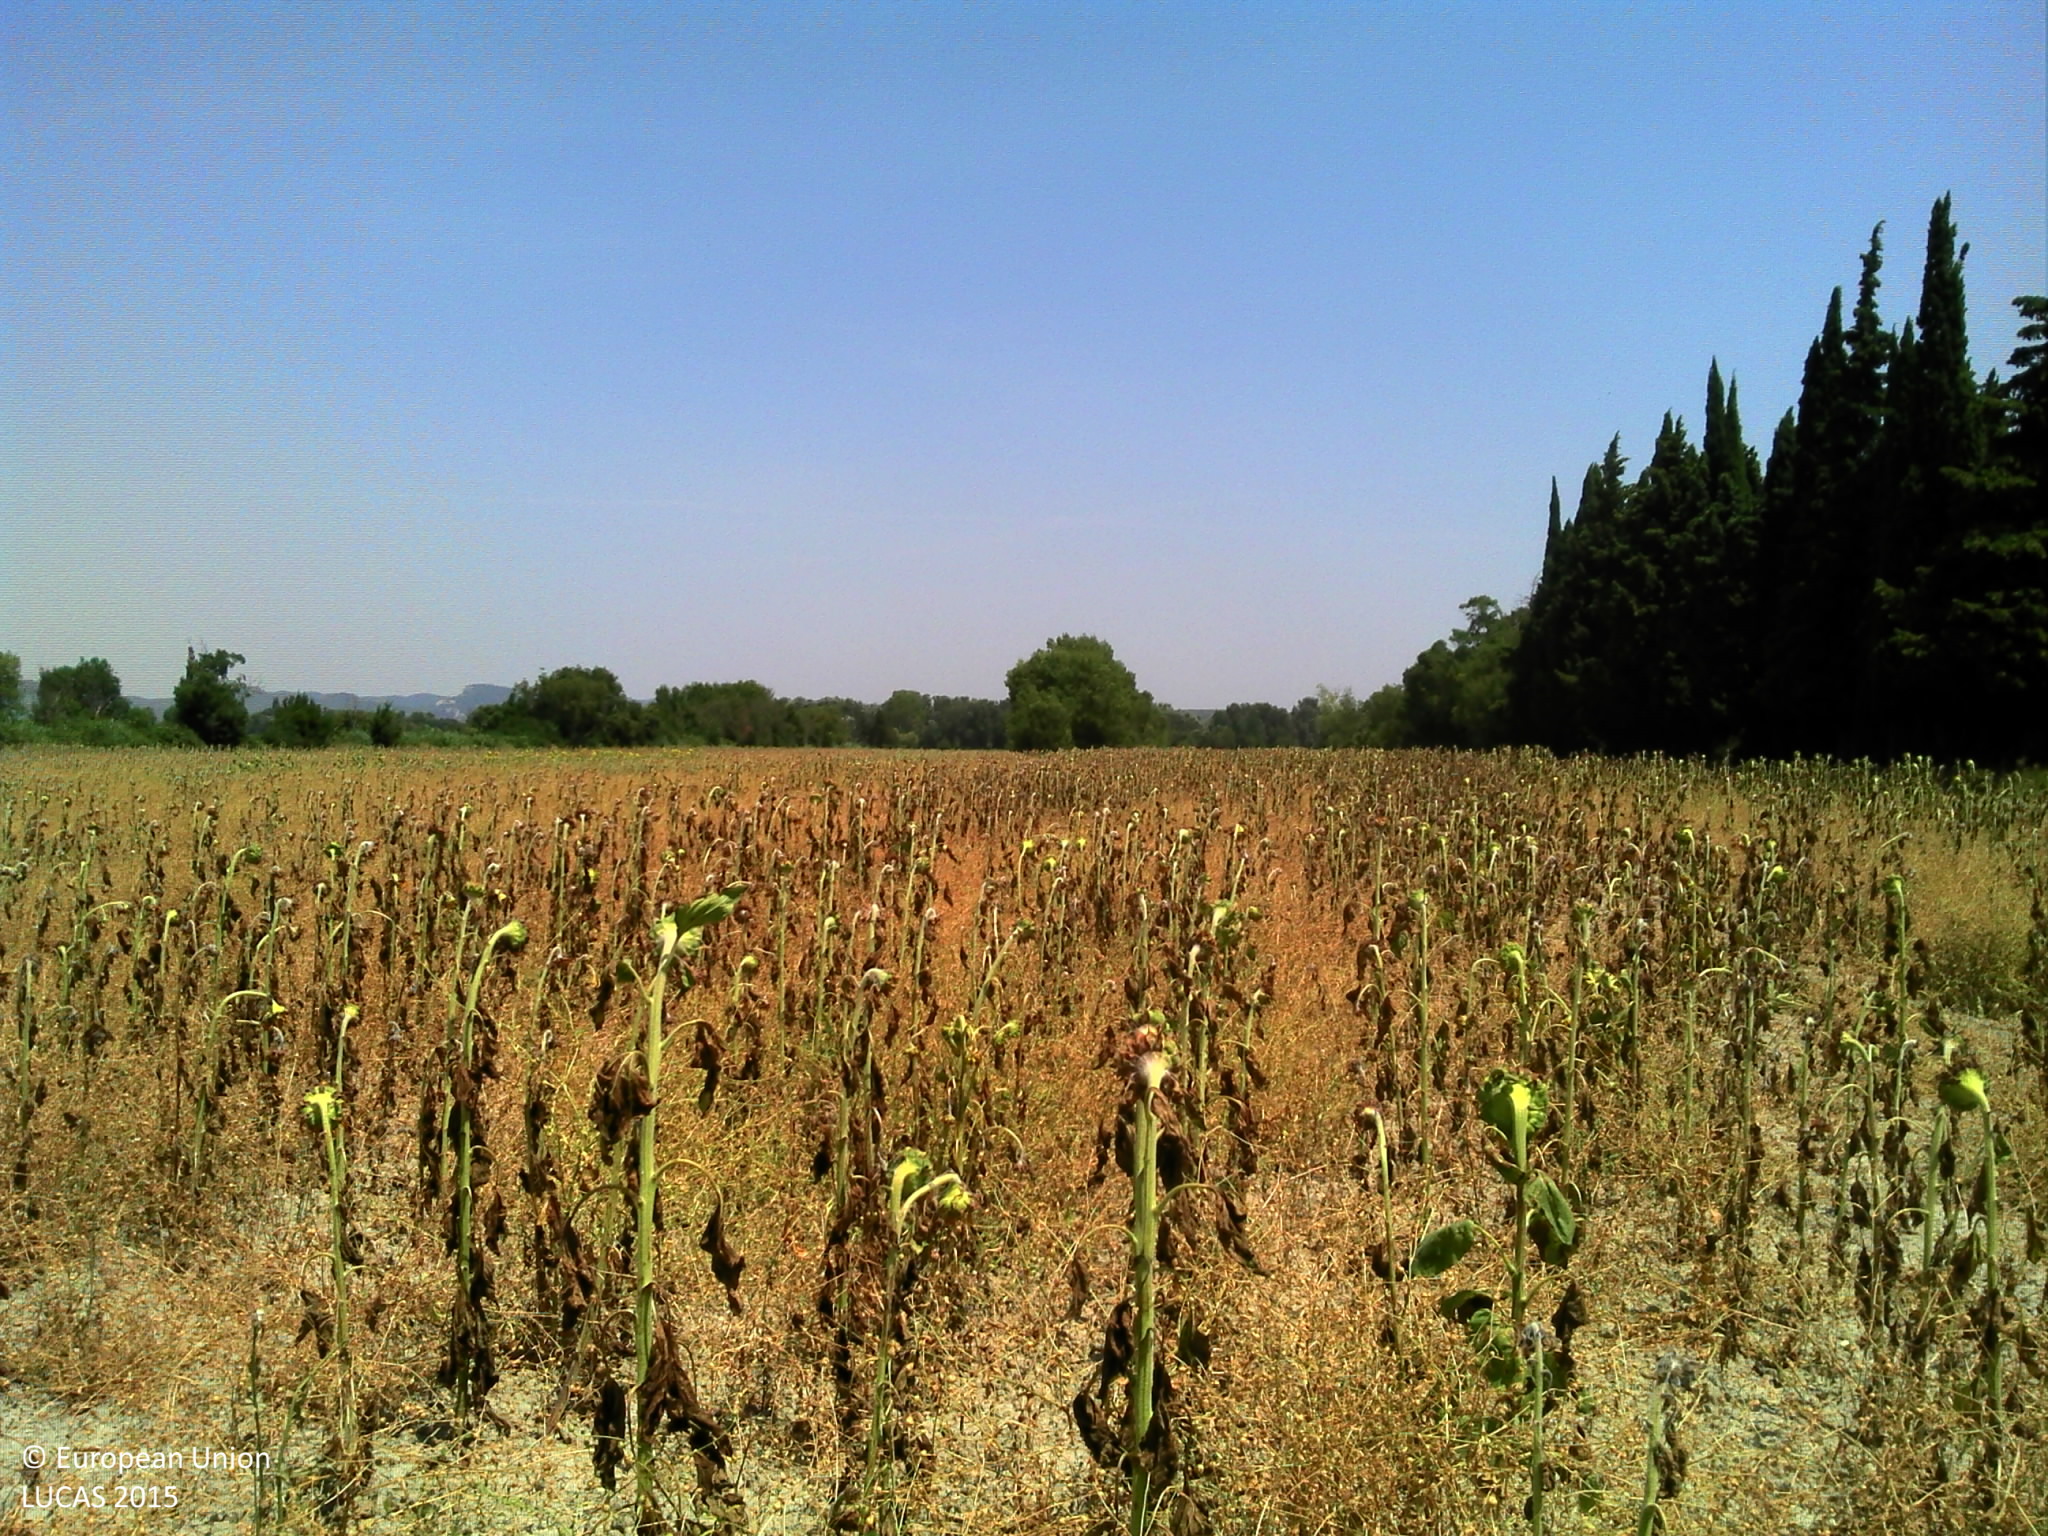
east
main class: Cropland
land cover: Sunflower
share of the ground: 25 - 50 %
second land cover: Spontaneously vegetated surfaces
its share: 25 - 50 %
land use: Agriculture (excluding fallow land and kitchen gardens)
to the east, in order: Sunflower; Spontaneously vegetated surfaces; Other bare soil; Grass margins; Fences; Conifer hedges; Spontaneously vegetated surfaces; Broadleaved woodland; Grassland without tree/shrub cover; Olive groves
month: July
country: FR
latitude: 43.7070
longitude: 4.6606
